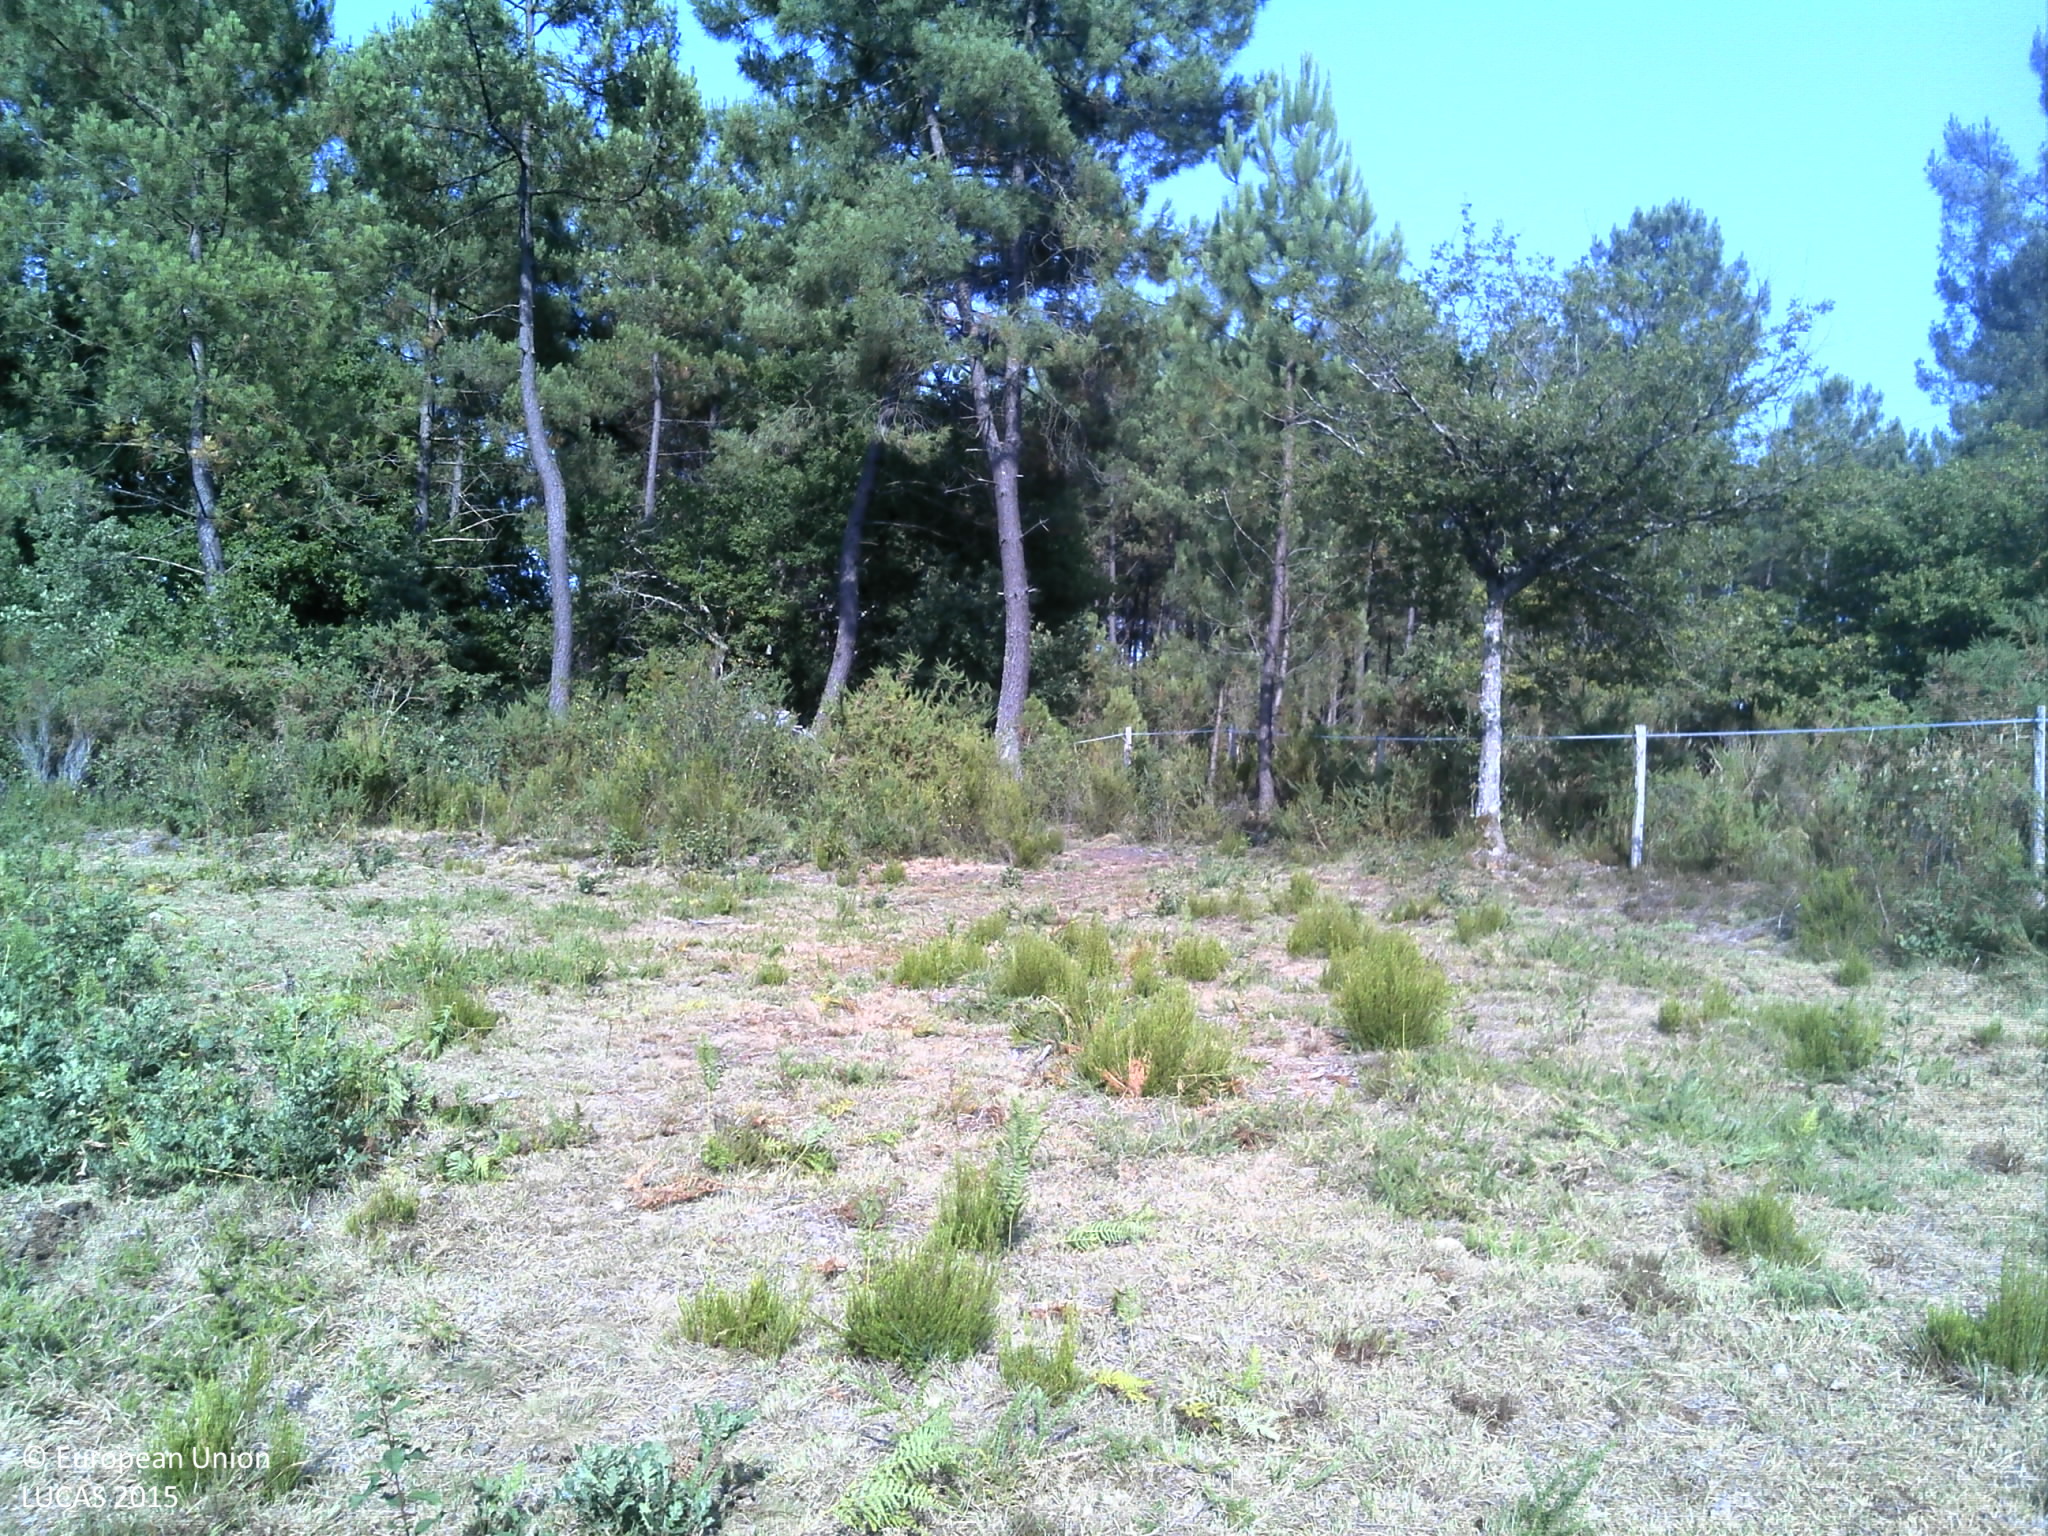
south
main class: Grassland
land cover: Spontaneously vegetated surfaces
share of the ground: > 75 %
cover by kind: herbaceous plants 95 %, shrubs 5 %
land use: Semi-natural and natural areas not in use
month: July
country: FR
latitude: 44.5840
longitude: -0.4572
